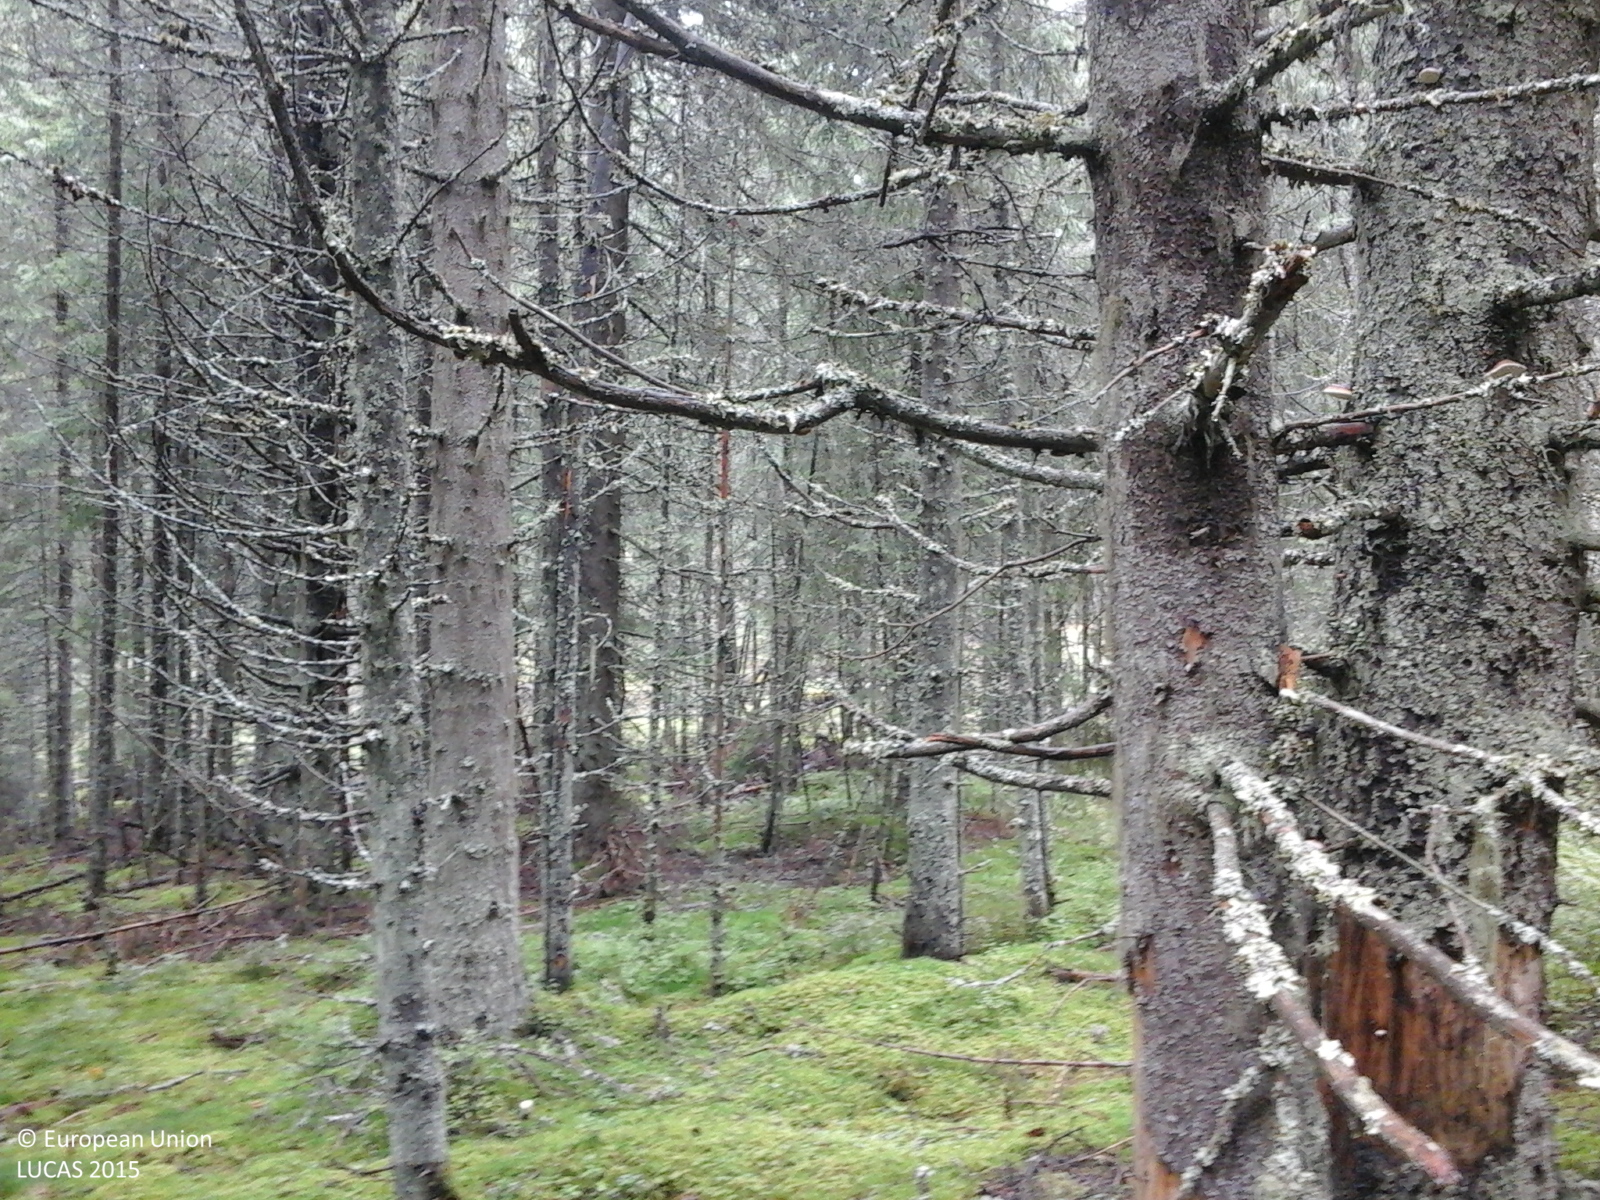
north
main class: Woodland
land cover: Spruce dominated coniferous woodland
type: alpine coniferous forest
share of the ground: > 75 %
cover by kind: coniferous forest trees 90 %, herbaceous plants 10 %
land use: Forestry
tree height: > 5 m
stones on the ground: 10 - 25 %
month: September
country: RO
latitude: 45.5924
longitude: 23.5607
